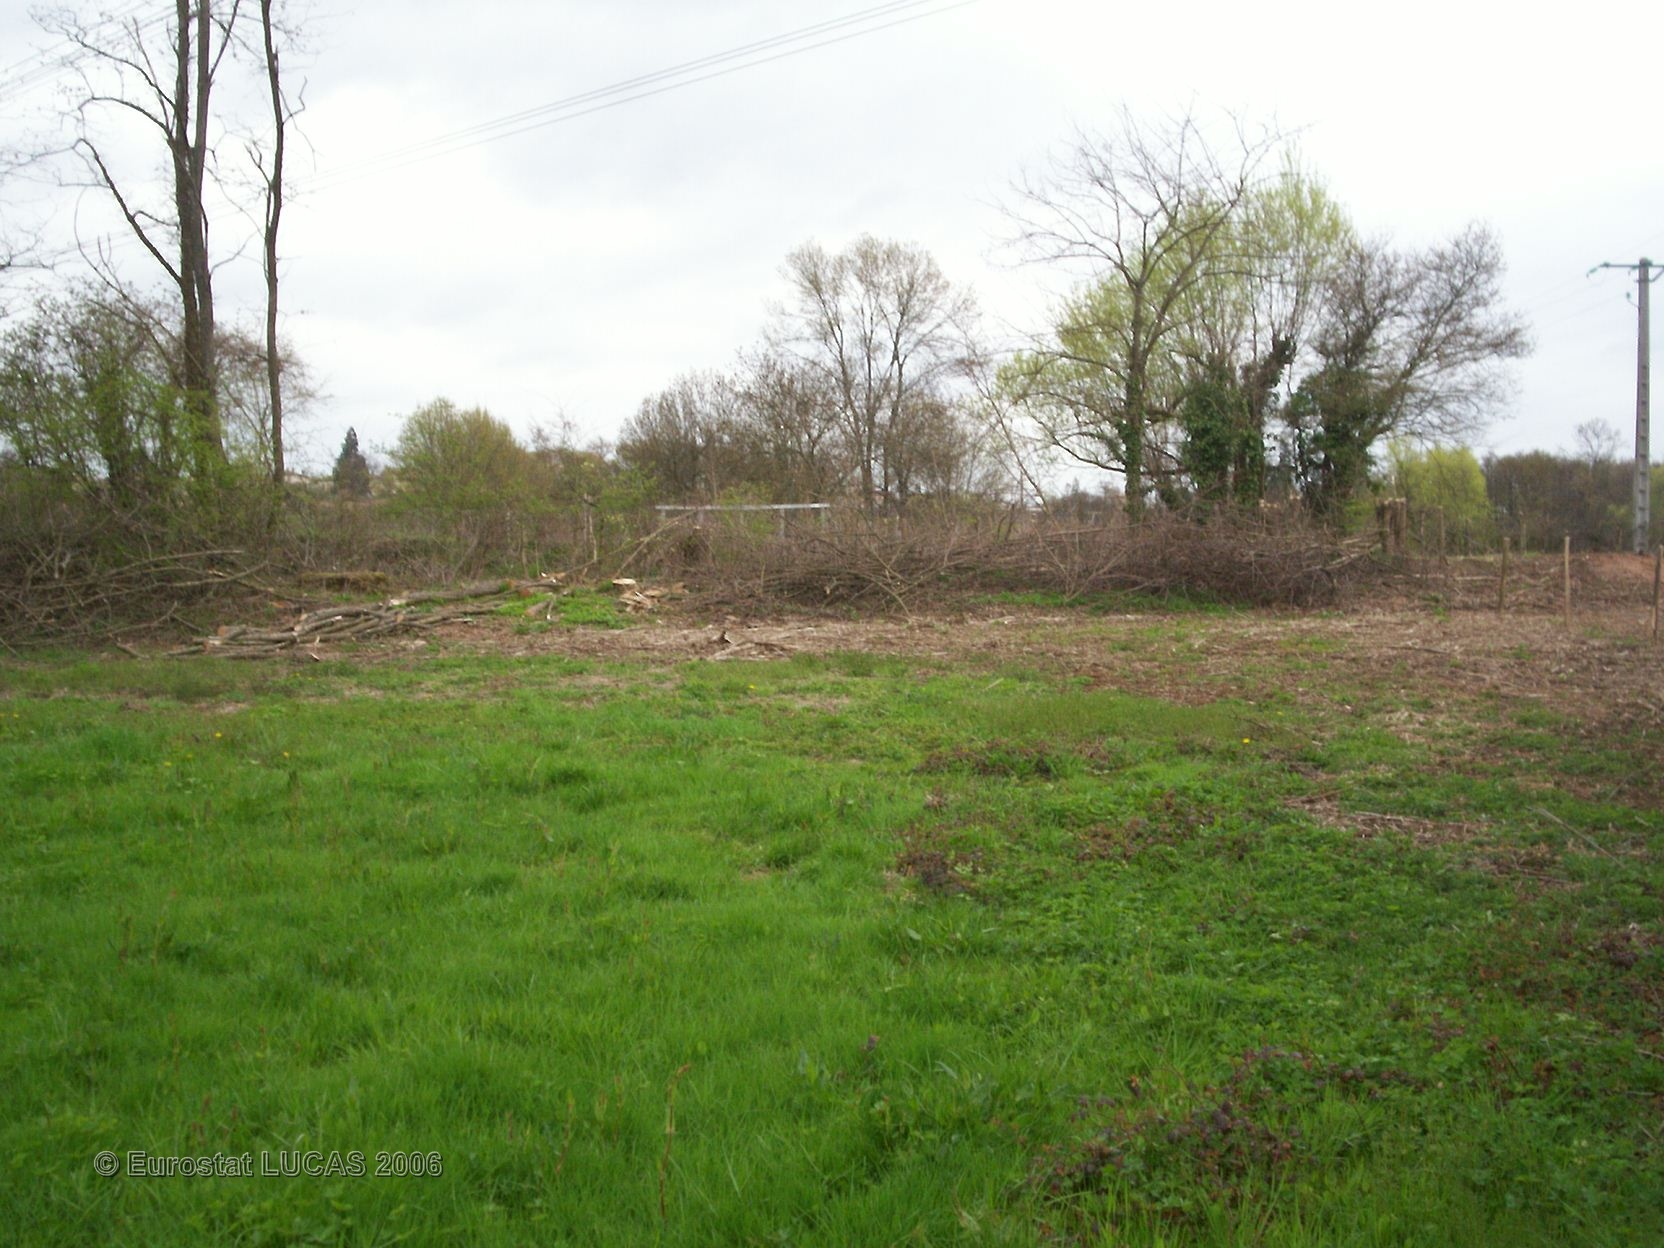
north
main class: Grassland
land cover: Grassland without tree/shrub cover
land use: Agriculture (excluding fallow land and kitchen gardens)
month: April
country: FR
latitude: 46.2044
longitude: 4.7535
